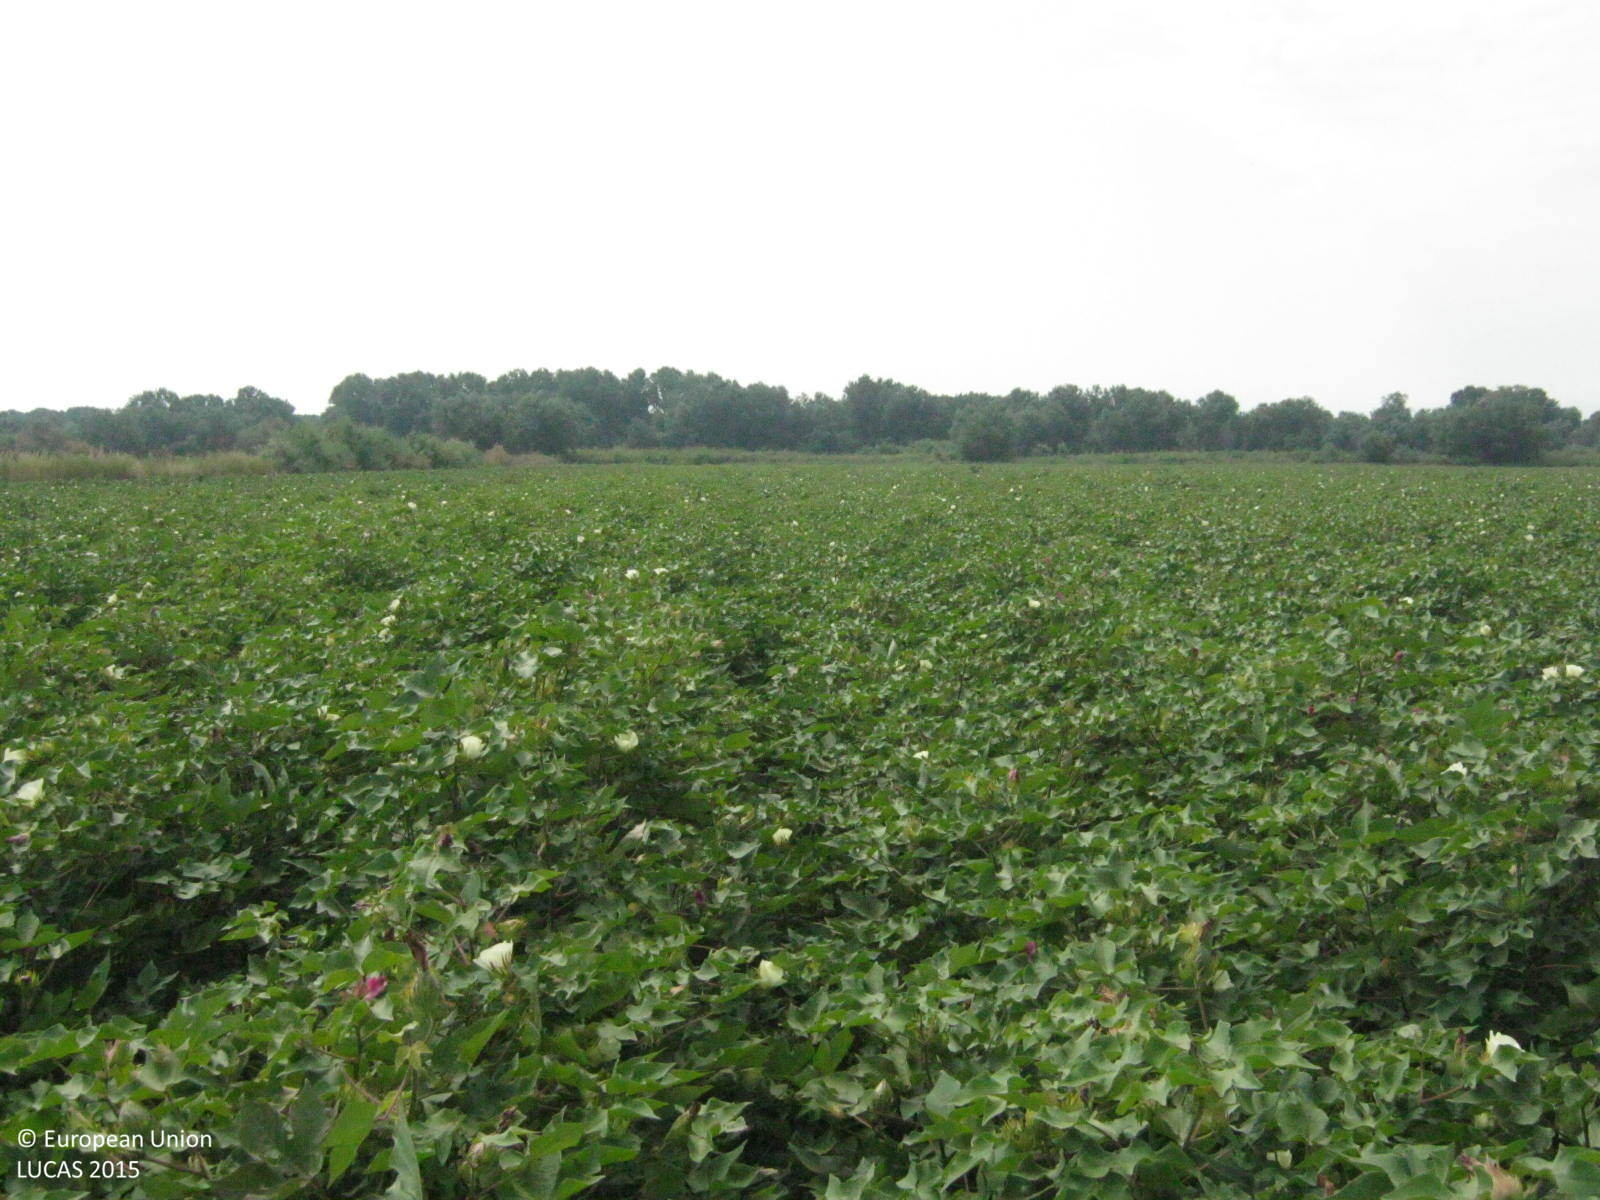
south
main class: Cropland
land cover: Cotton
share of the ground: > 75 %
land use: Agriculture (excluding fallow land and kitchen gardens)
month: August
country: GR
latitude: 40.5543
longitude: 22.5552
